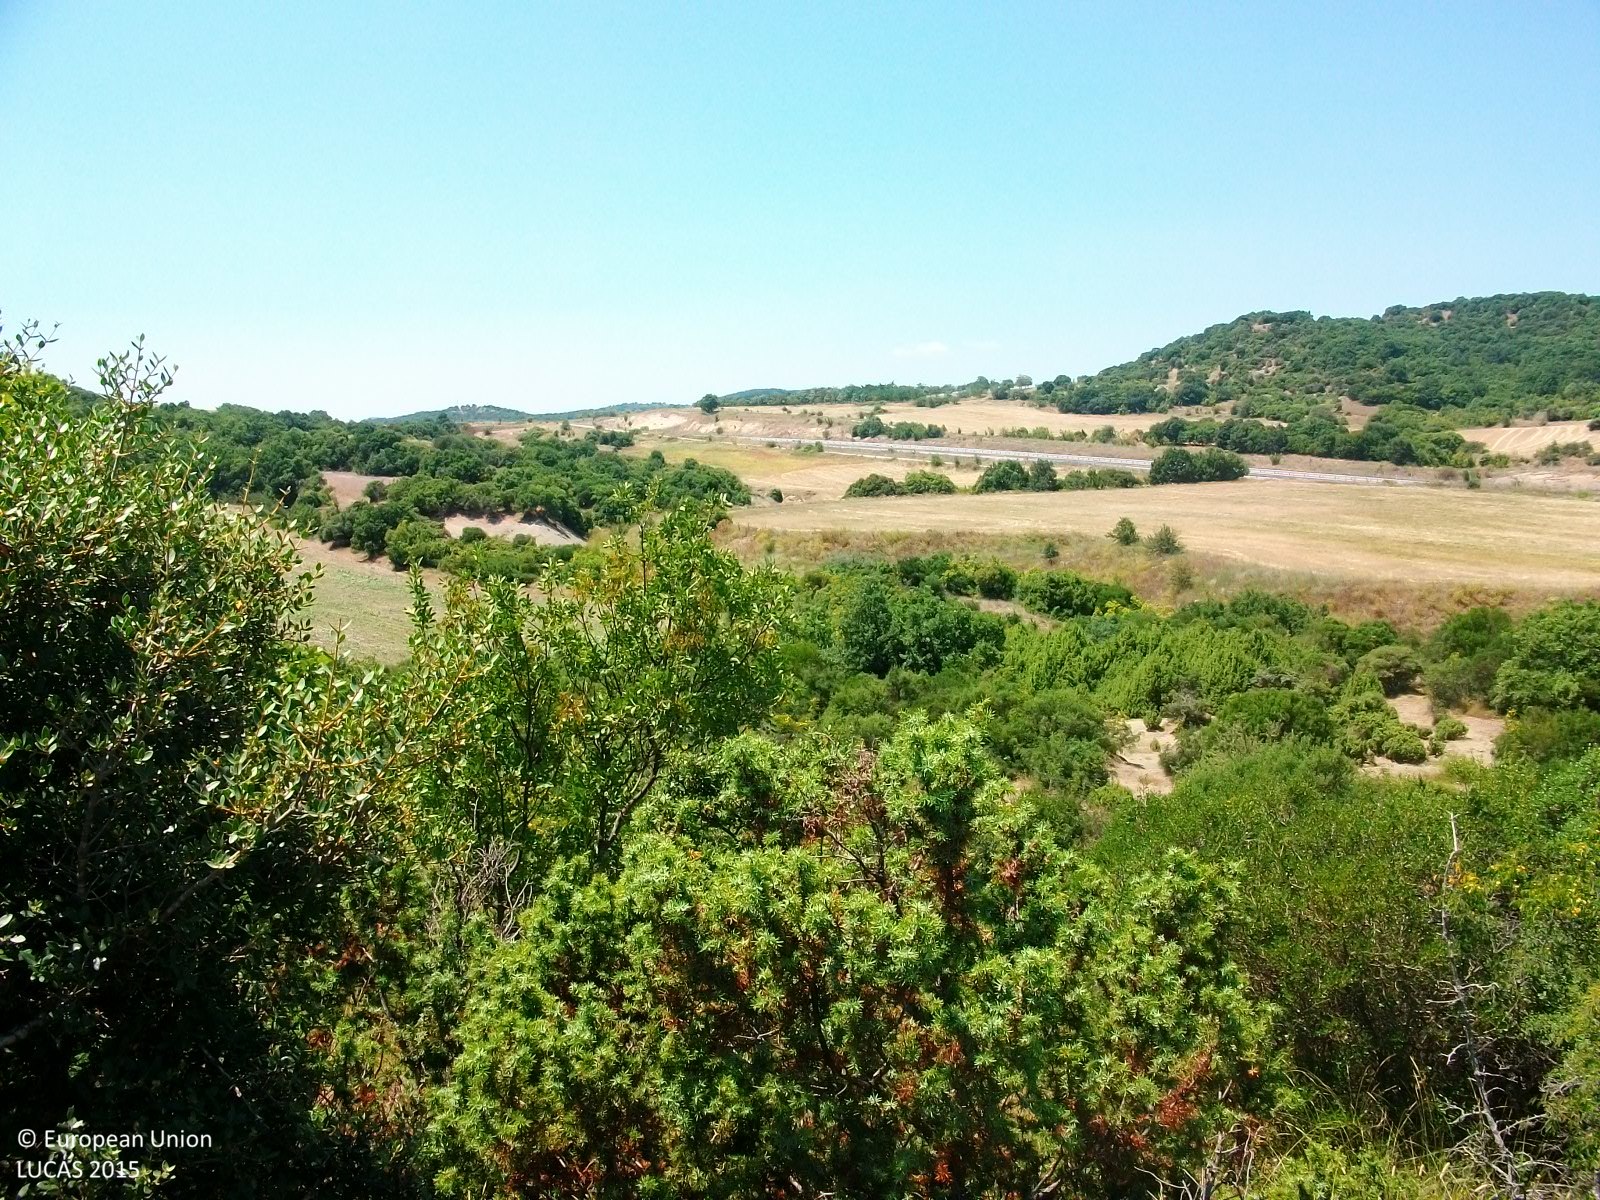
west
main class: Shrubland
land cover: Shrubland with sparse tree cover
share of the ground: 50 - 75 %
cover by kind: shrubs 70 %, herbaceous plants 25 %, broadleaved forest trees 5 %
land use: Semi-natural and natural areas not in use
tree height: < 5 m
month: July
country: GR
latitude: 40.9245
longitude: 26.1534
